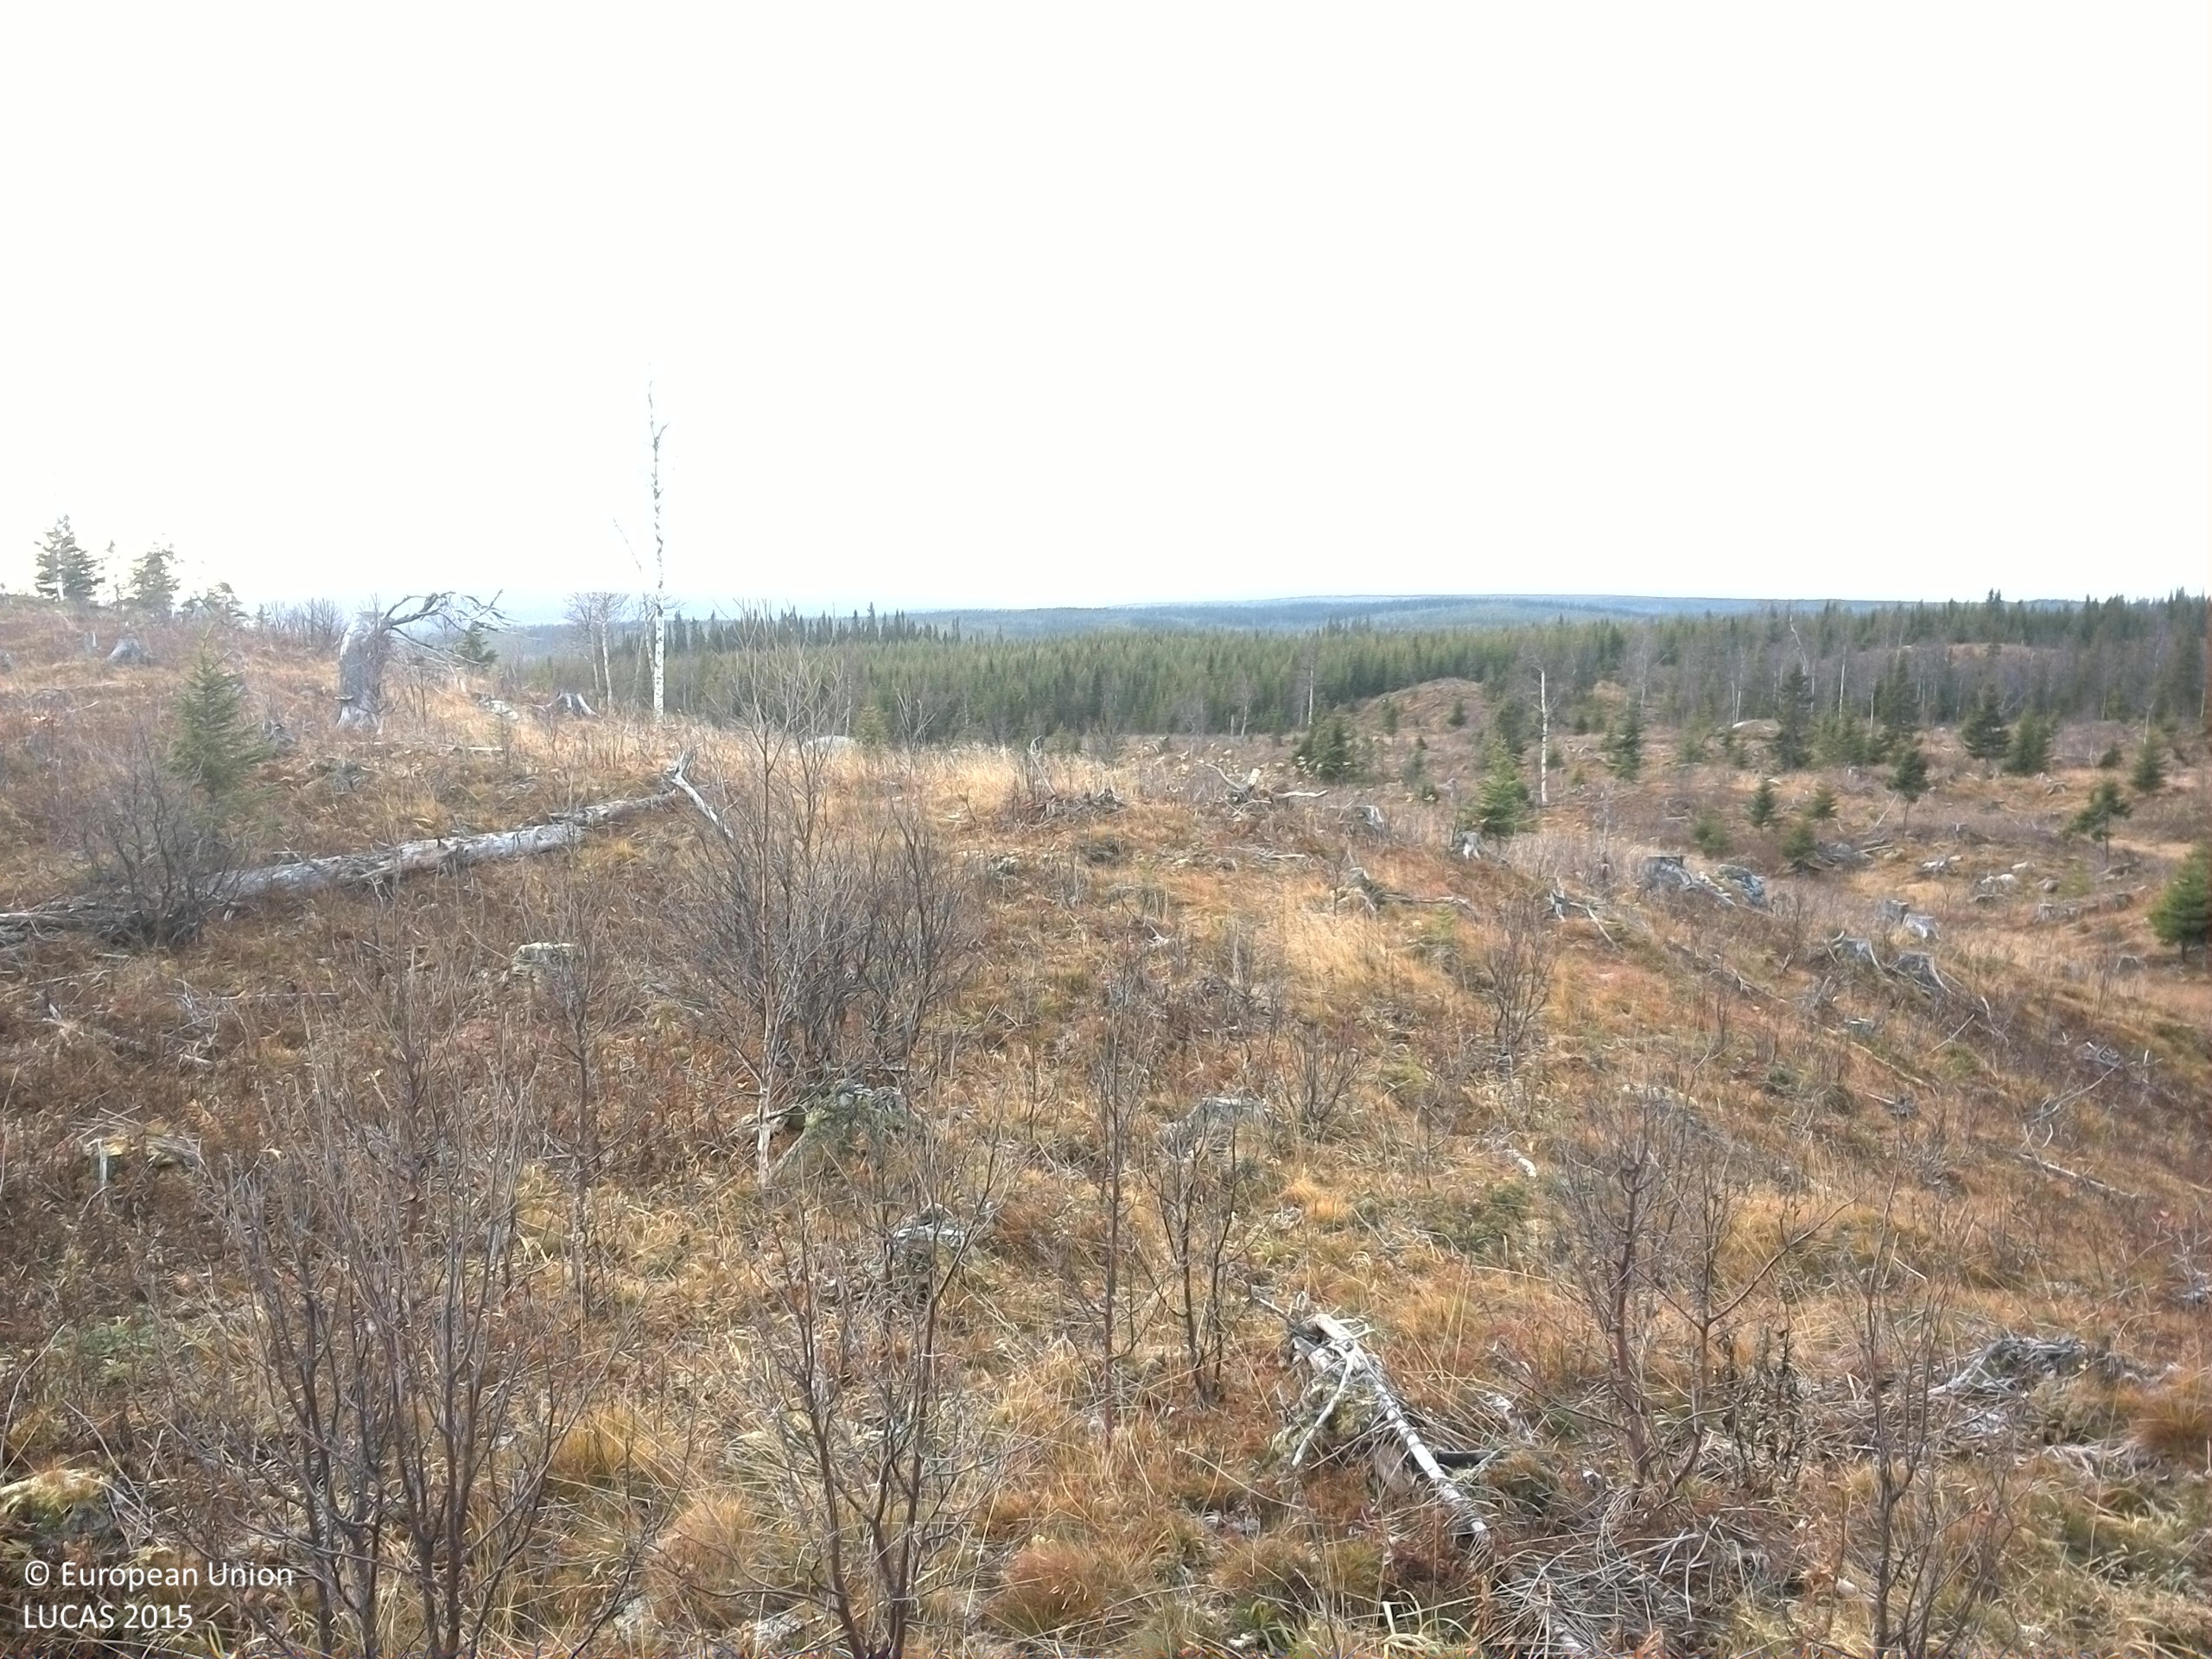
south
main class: Woodland
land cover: Spruce dominated mixed woodland
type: boreal forest
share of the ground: 10 - 25 %
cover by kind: herbaceous plants 55 %, lichens and mosses 20 %, shrubs 15 %, coniferous forest trees 5 %, broadleaved forest trees 5 %
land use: Forestry
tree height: < 5 m
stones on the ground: 25 - 50 %
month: October
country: SE
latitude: 64.1122
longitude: 15.2486
